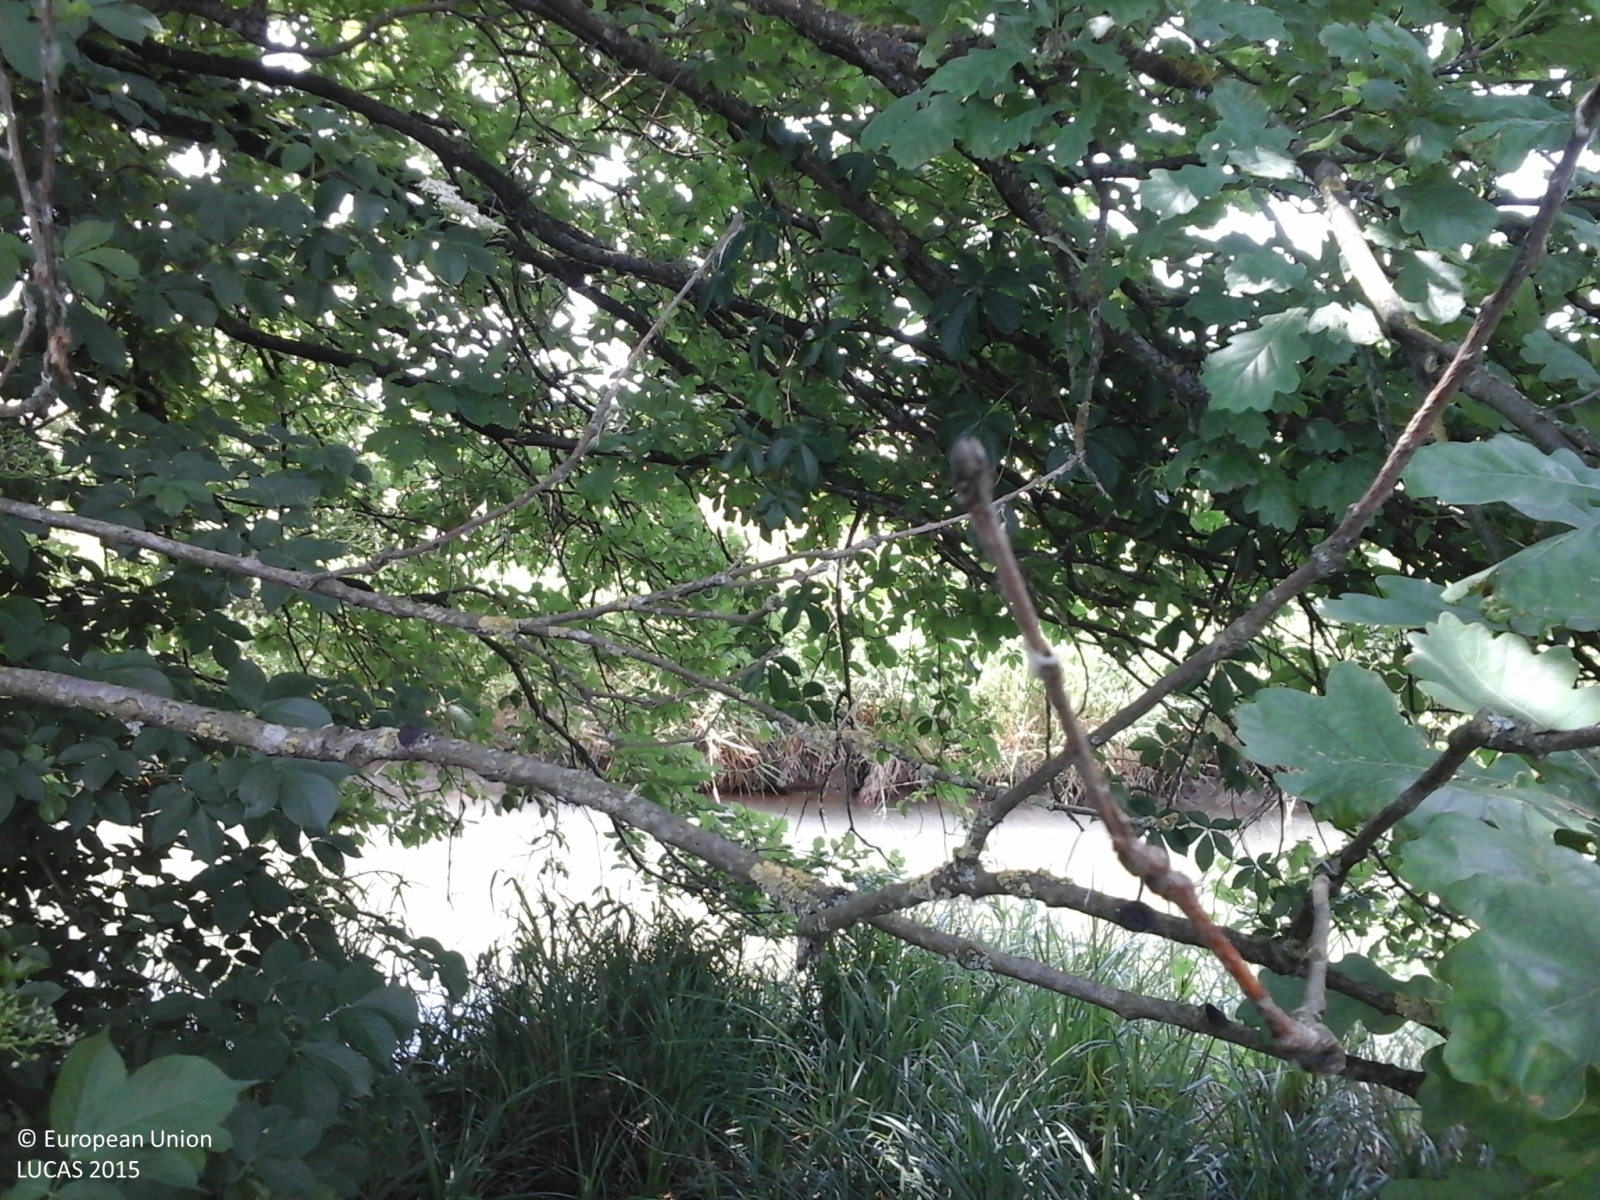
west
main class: Woodland
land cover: Broadleaved woodland
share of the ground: 50 - 75 %
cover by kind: broadleaved forest trees 50 %, herbaceous plants 40 %, shrubs 10 %
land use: Semi-natural and natural areas not in use
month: May
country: IT
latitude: 45.2304
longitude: 9.1228
